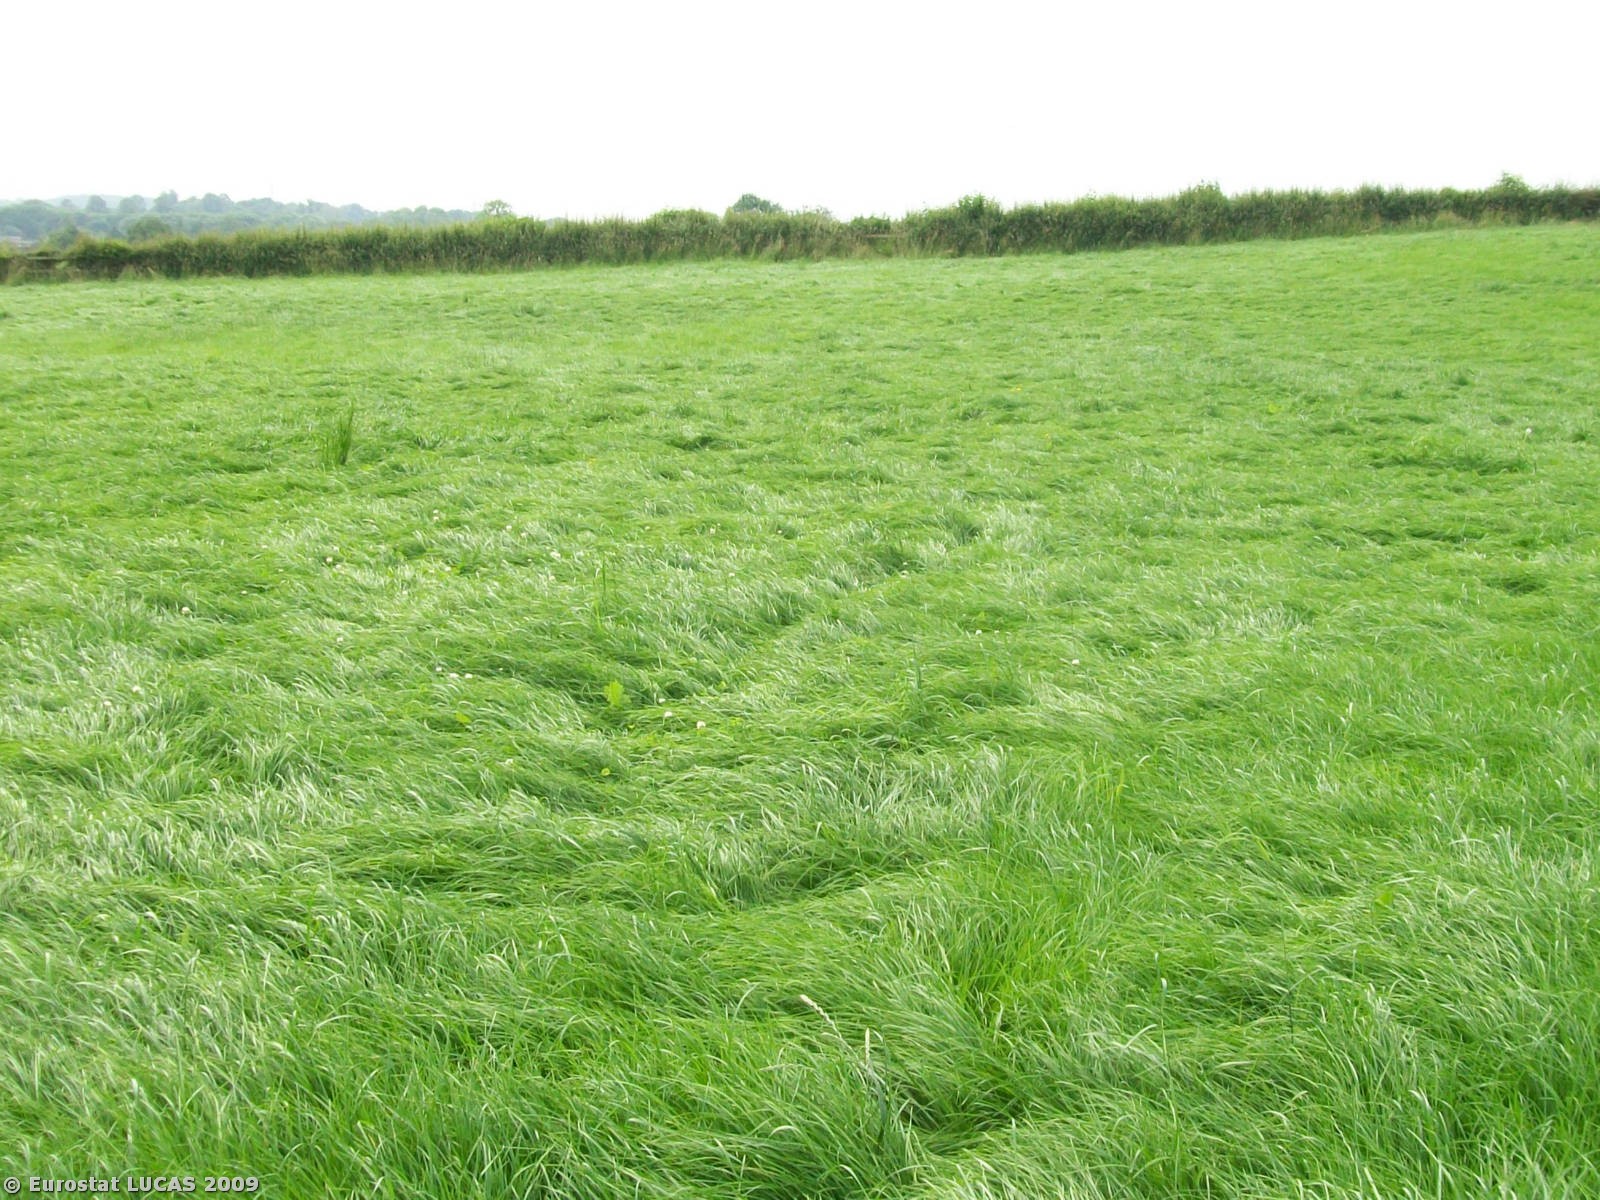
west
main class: Grassland
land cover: Grassland without tree/shrub cover
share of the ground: < 10 %
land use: Agriculture (excluding fallow land and kitchen gardens)
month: June
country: GB
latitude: 54.0670
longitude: -1.5250
